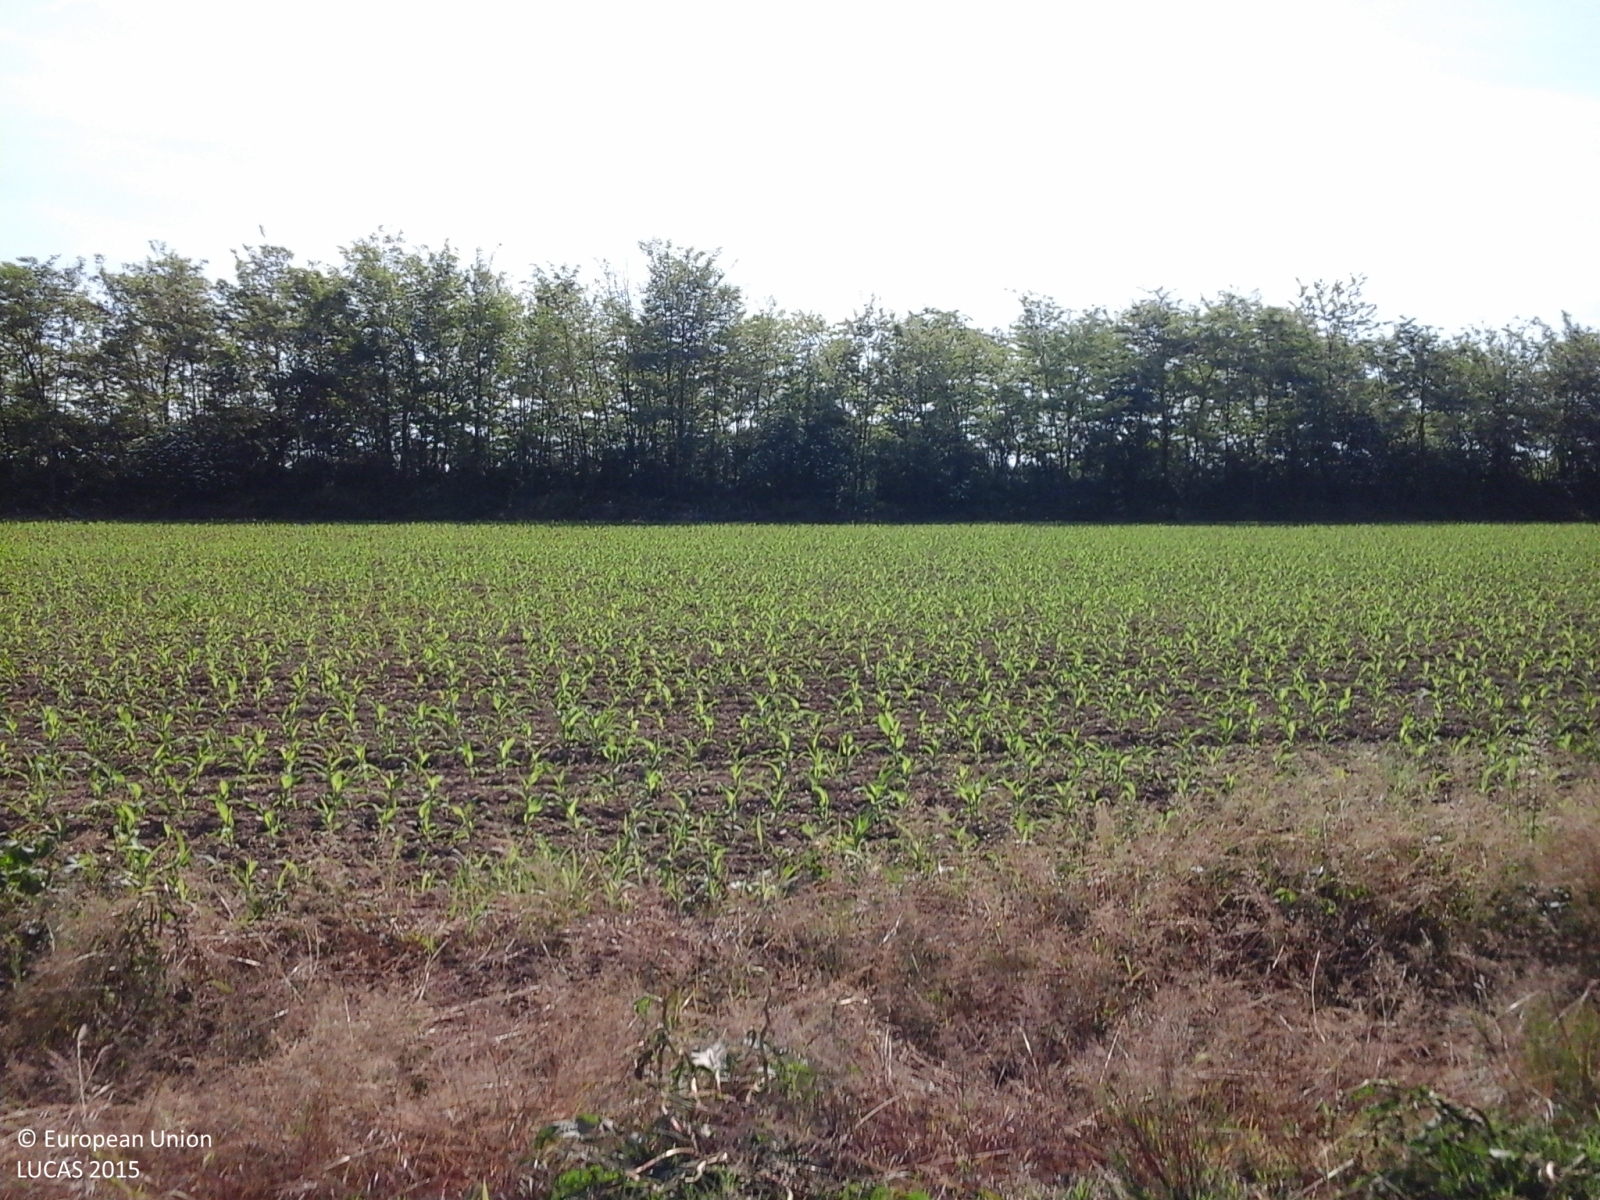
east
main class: Cropland
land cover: Maize
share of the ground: 10 - 25 %
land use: Agriculture (excluding fallow land and kitchen gardens)
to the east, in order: Maize; Grass margins; Ditches and canals; Maize; Broadleaved woodland; Paved roads, cycling and walking lanes; Broadleaved woodland; Barley; Grass margins; Paved roads, cycling and walking lanes; Grass margins; Ditches and canals; Grassland without tree/shrub cover
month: May
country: IT
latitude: 45.5548
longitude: 9.1176
